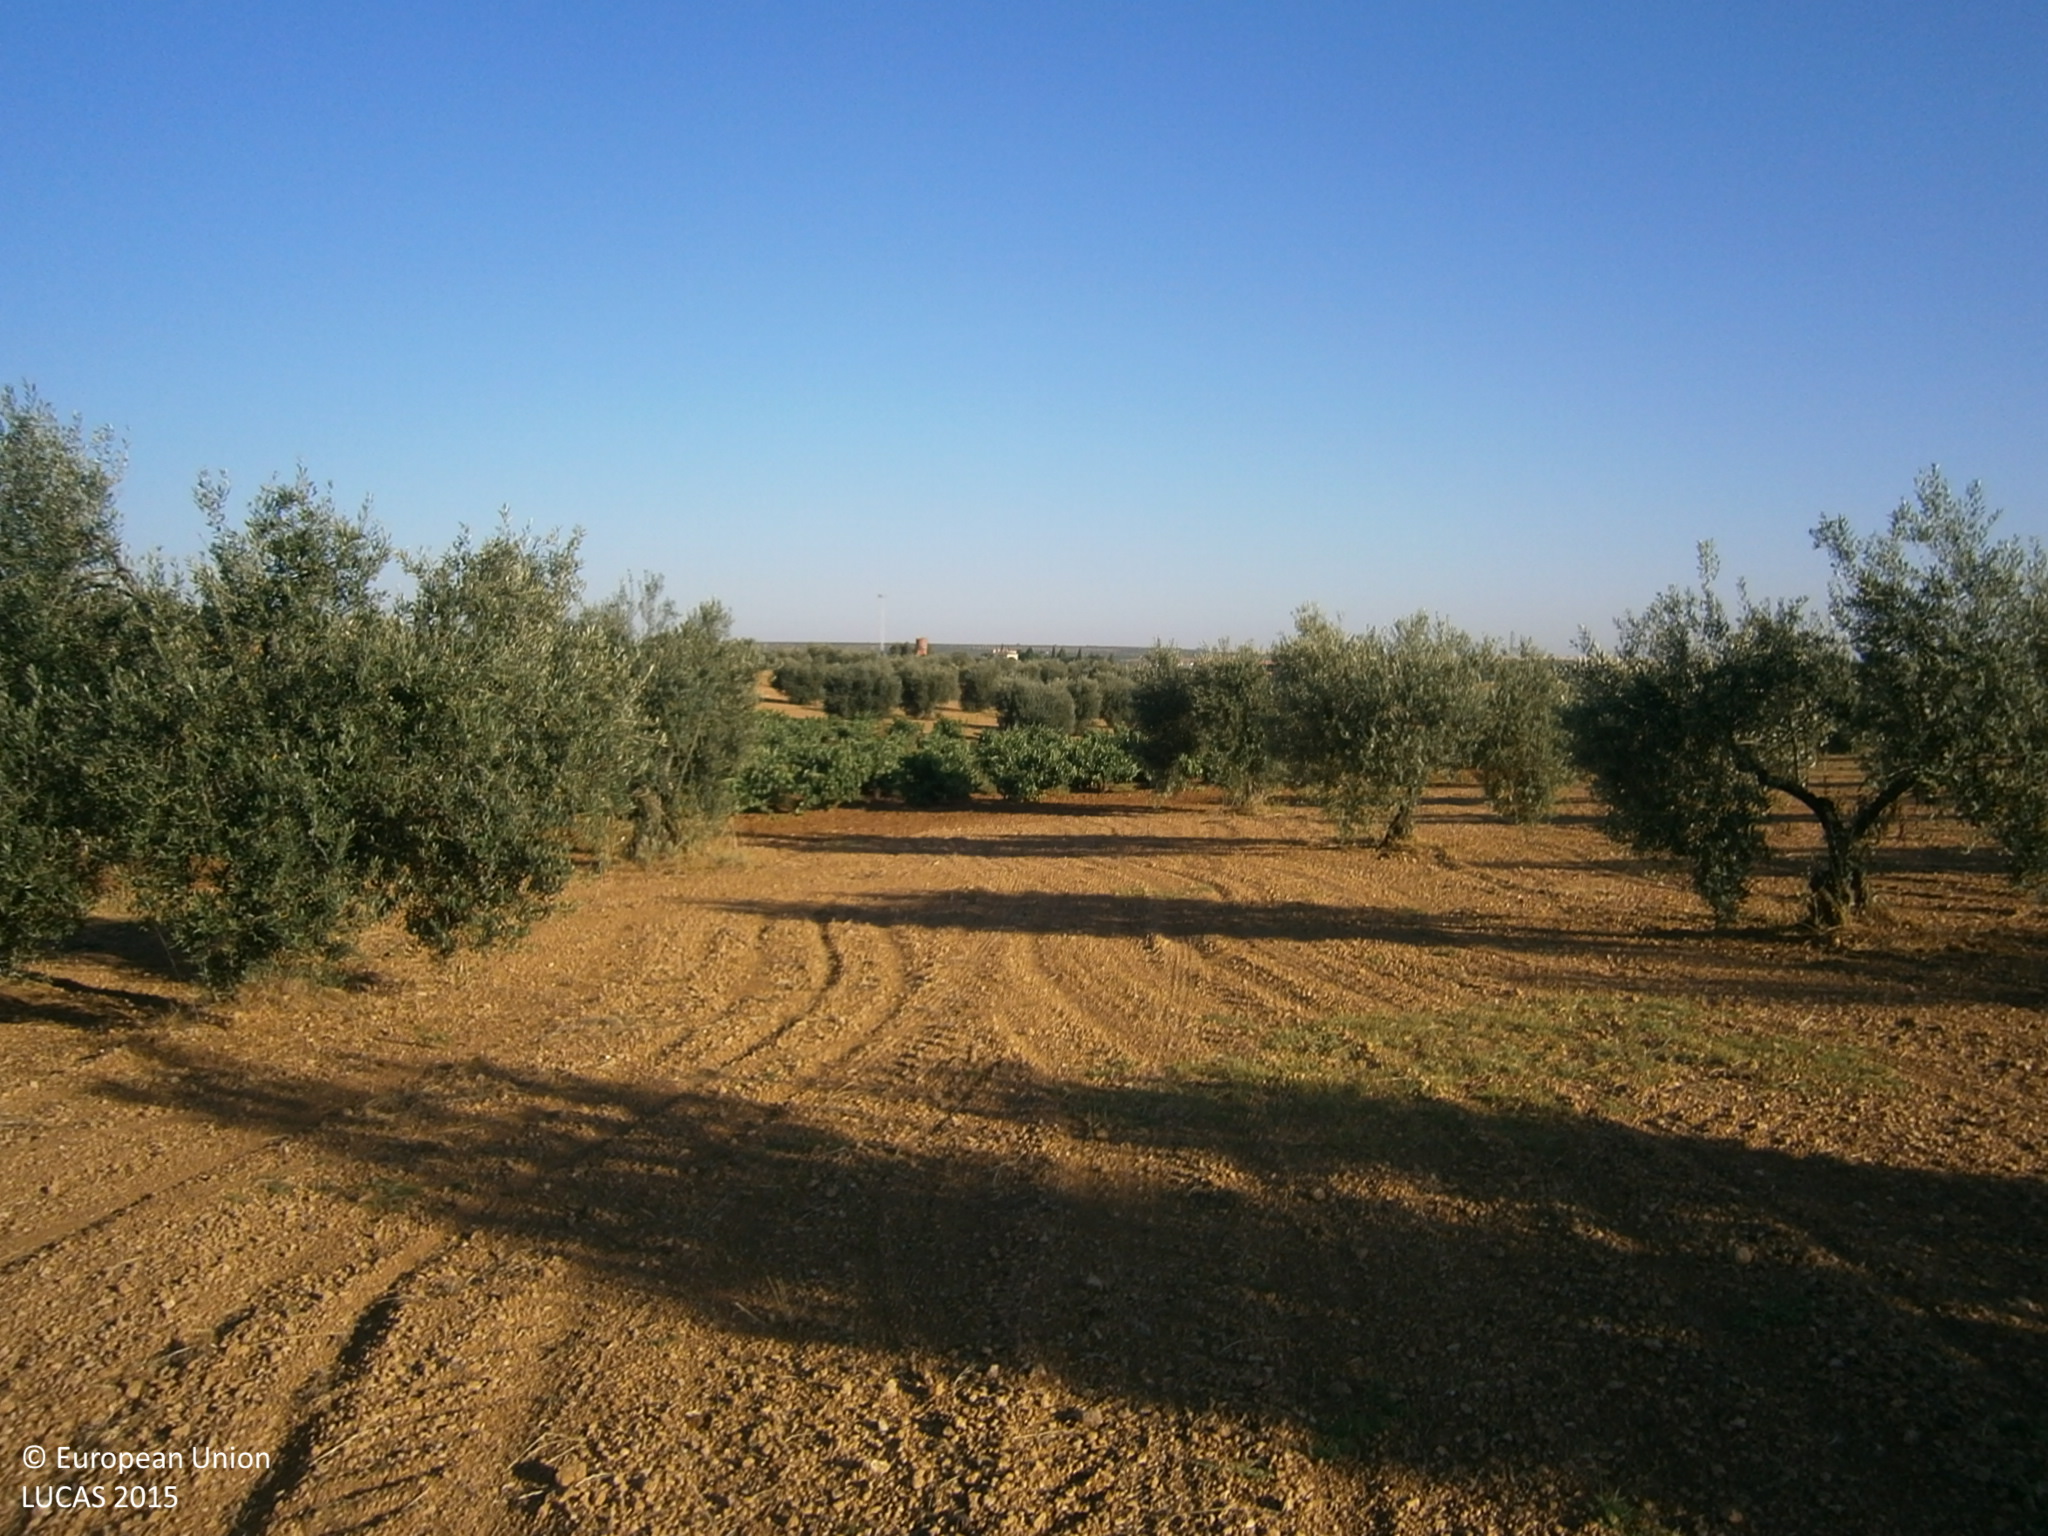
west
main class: Cropland
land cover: Olive groves
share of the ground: 10 - 25 %
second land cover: Other bare soil
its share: > 75 %
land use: Agriculture (excluding fallow land and kitchen gardens)
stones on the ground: 10 - 25 %
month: June
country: ES
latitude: 38.7135
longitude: -6.7023
